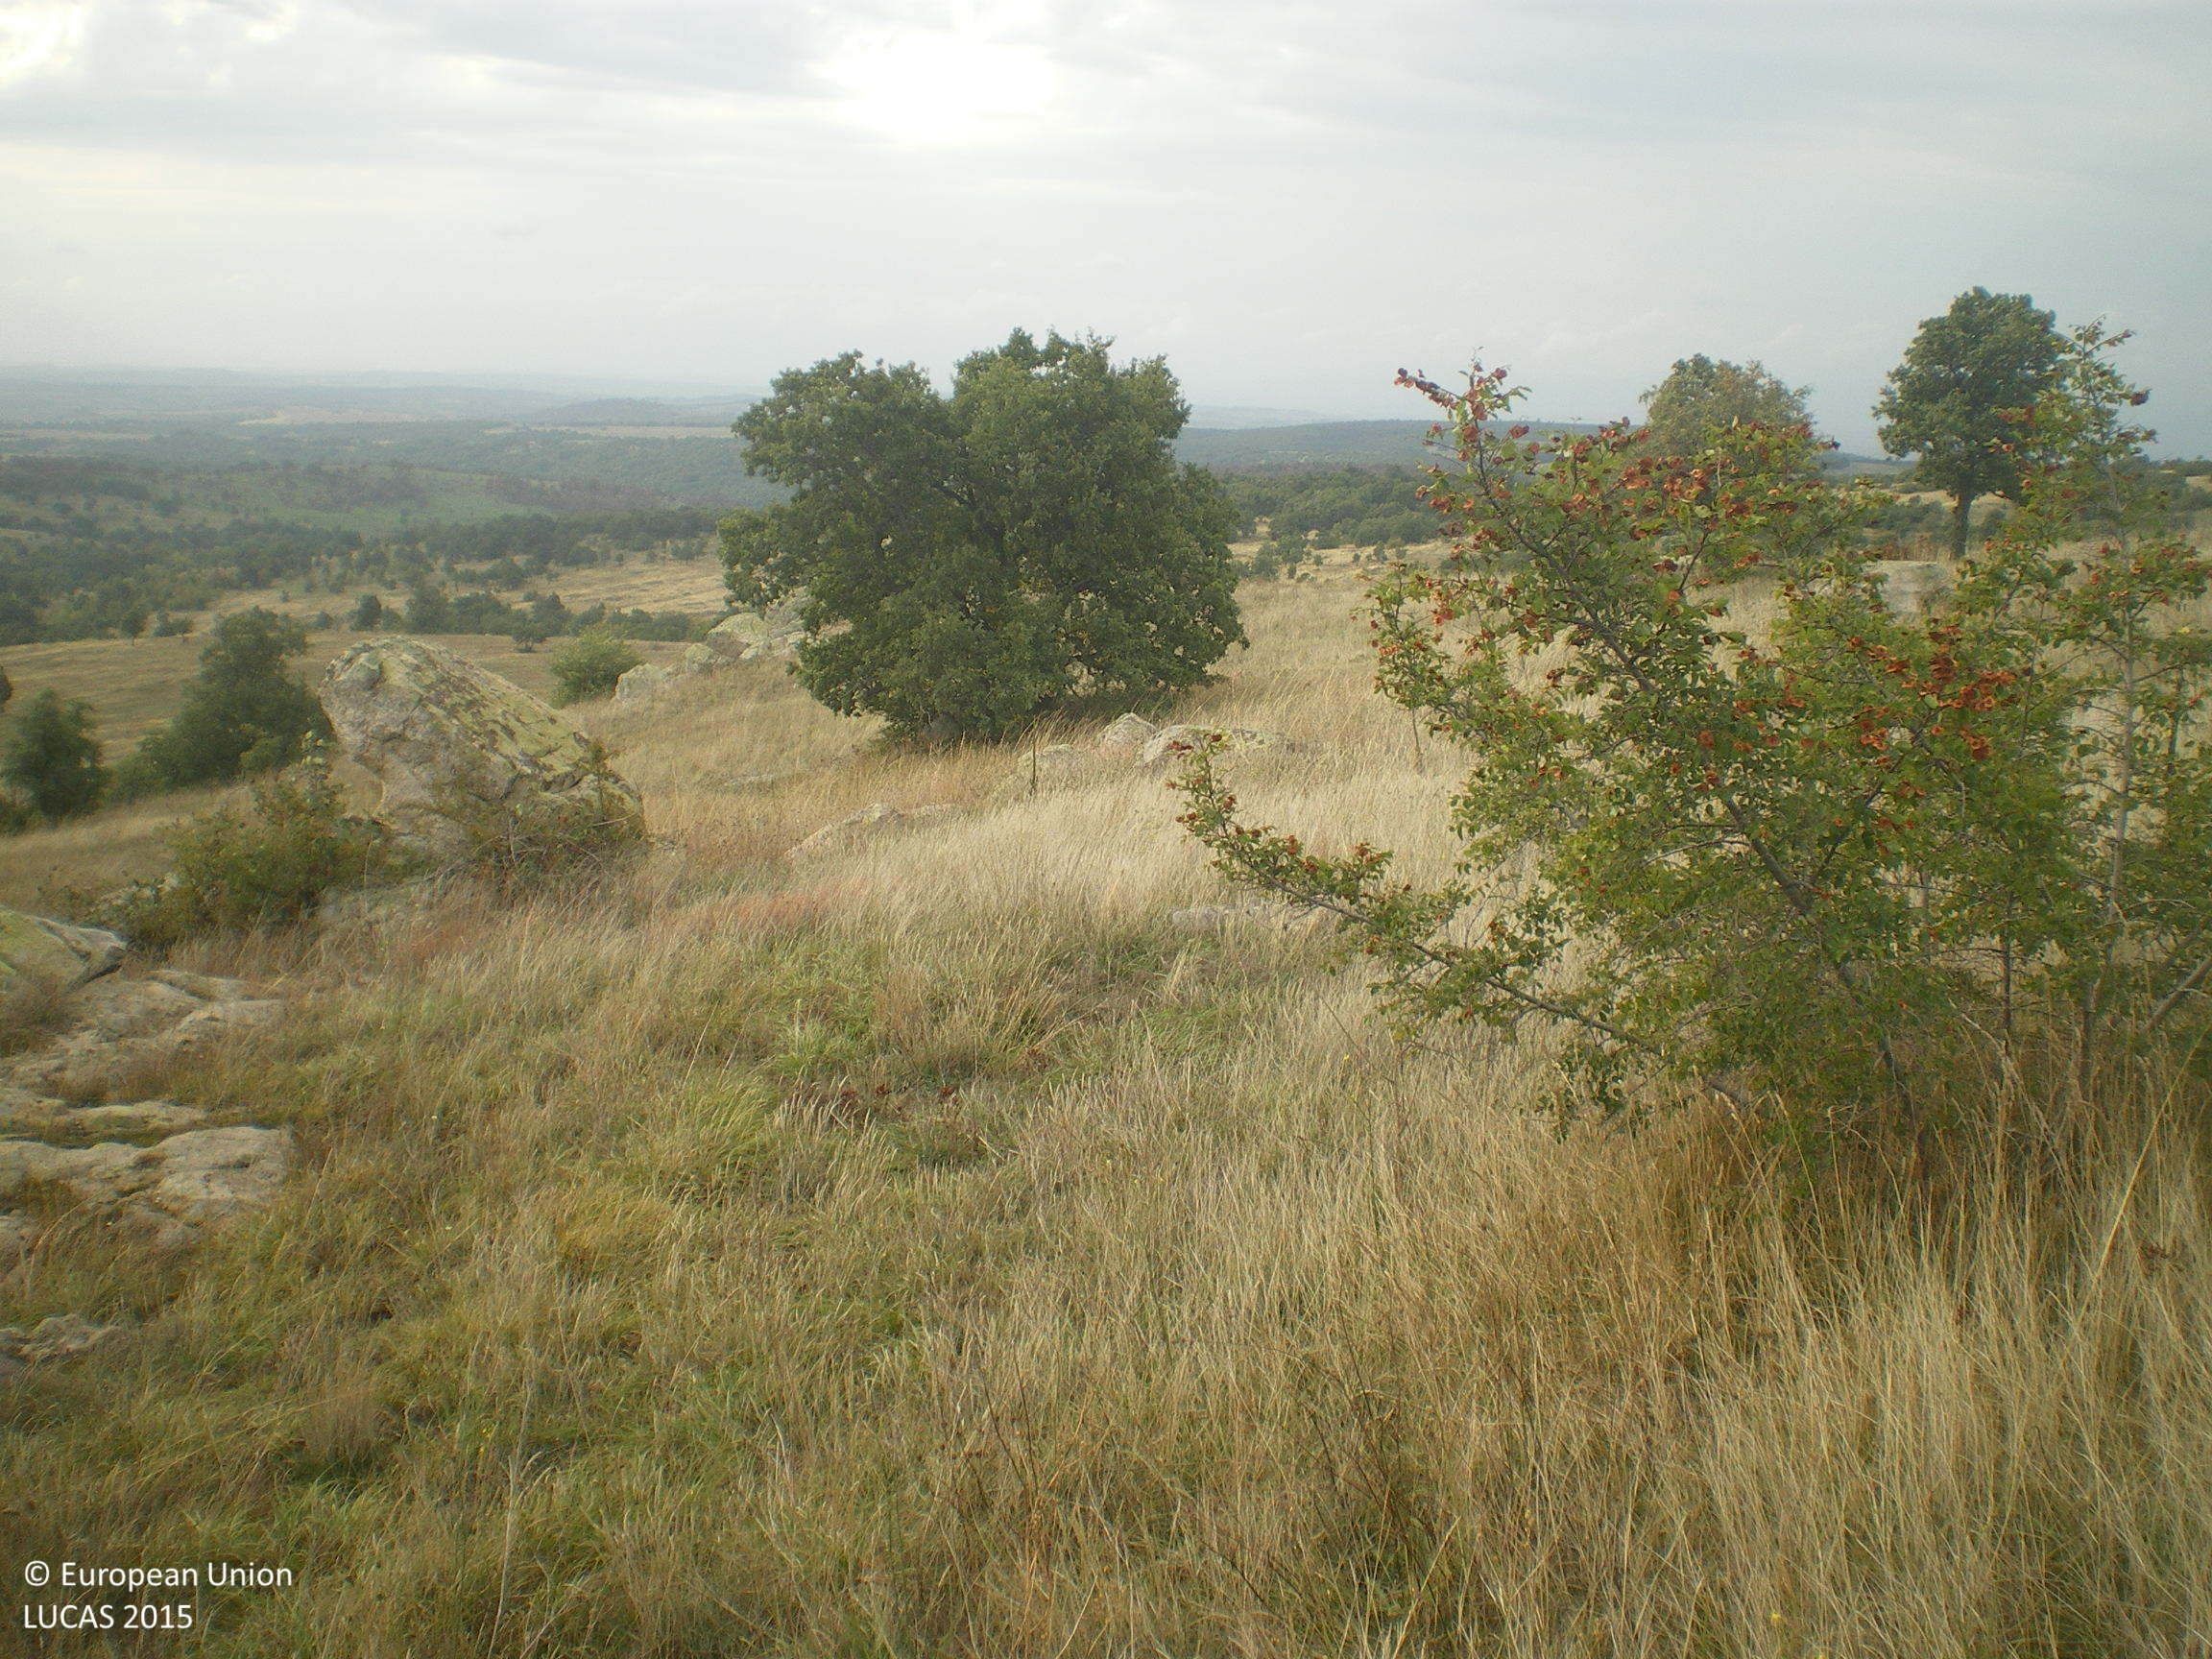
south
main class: Grassland
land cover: Grassland with sparse tree/shrub cover
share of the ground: > 75 %
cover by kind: herbaceous plants 85 %, broadleaved forest trees 5 %, shrubs 5 %, unconsolidated bare surface 5 %
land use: Agriculture (excluding fallow land and kitchen gardens)
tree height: > 5 m
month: October
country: BG
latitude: 41.9845
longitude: 26.1917
